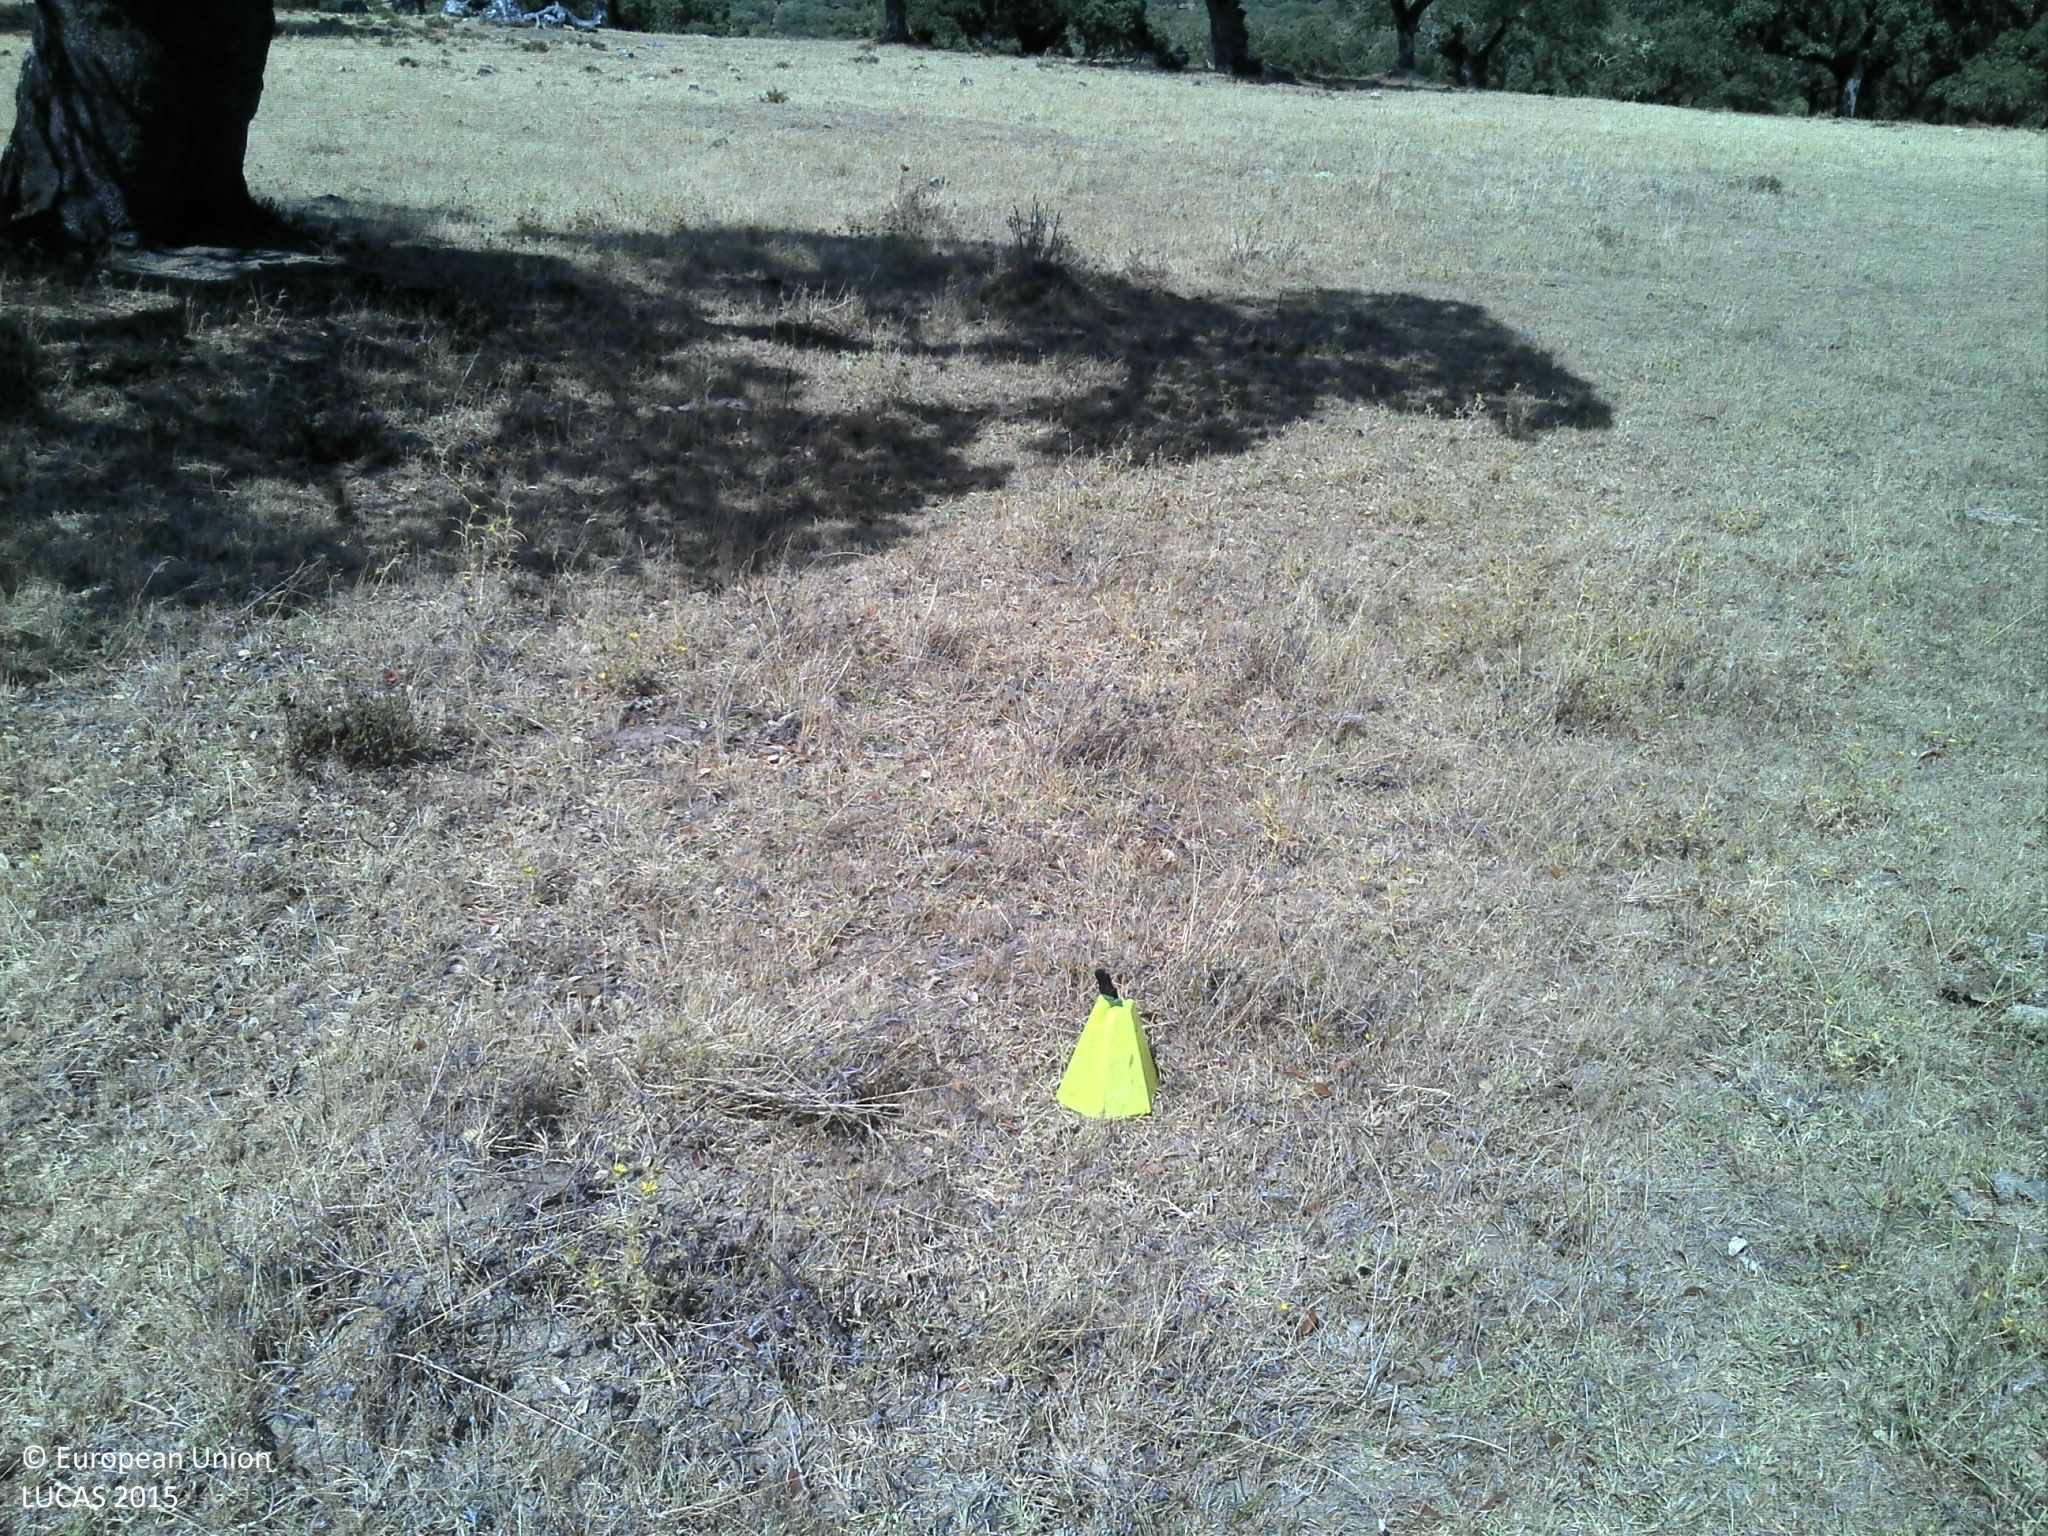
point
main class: Woodland
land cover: Broadleaved woodland
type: broadleaved evergreen forest
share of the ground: 10 - 25 %
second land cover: Grassland without tree/shrub cover
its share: 10 - 25 %
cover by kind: unconsolidated bare surface 70 %, broadleaved forest trees 15 %, herbaceous plants 15 %
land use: Forestry
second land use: Agriculture (excluding fallow land and kitchen gardens)
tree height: > 5 m
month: July
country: PT
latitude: 39.1599
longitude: -7.5041
